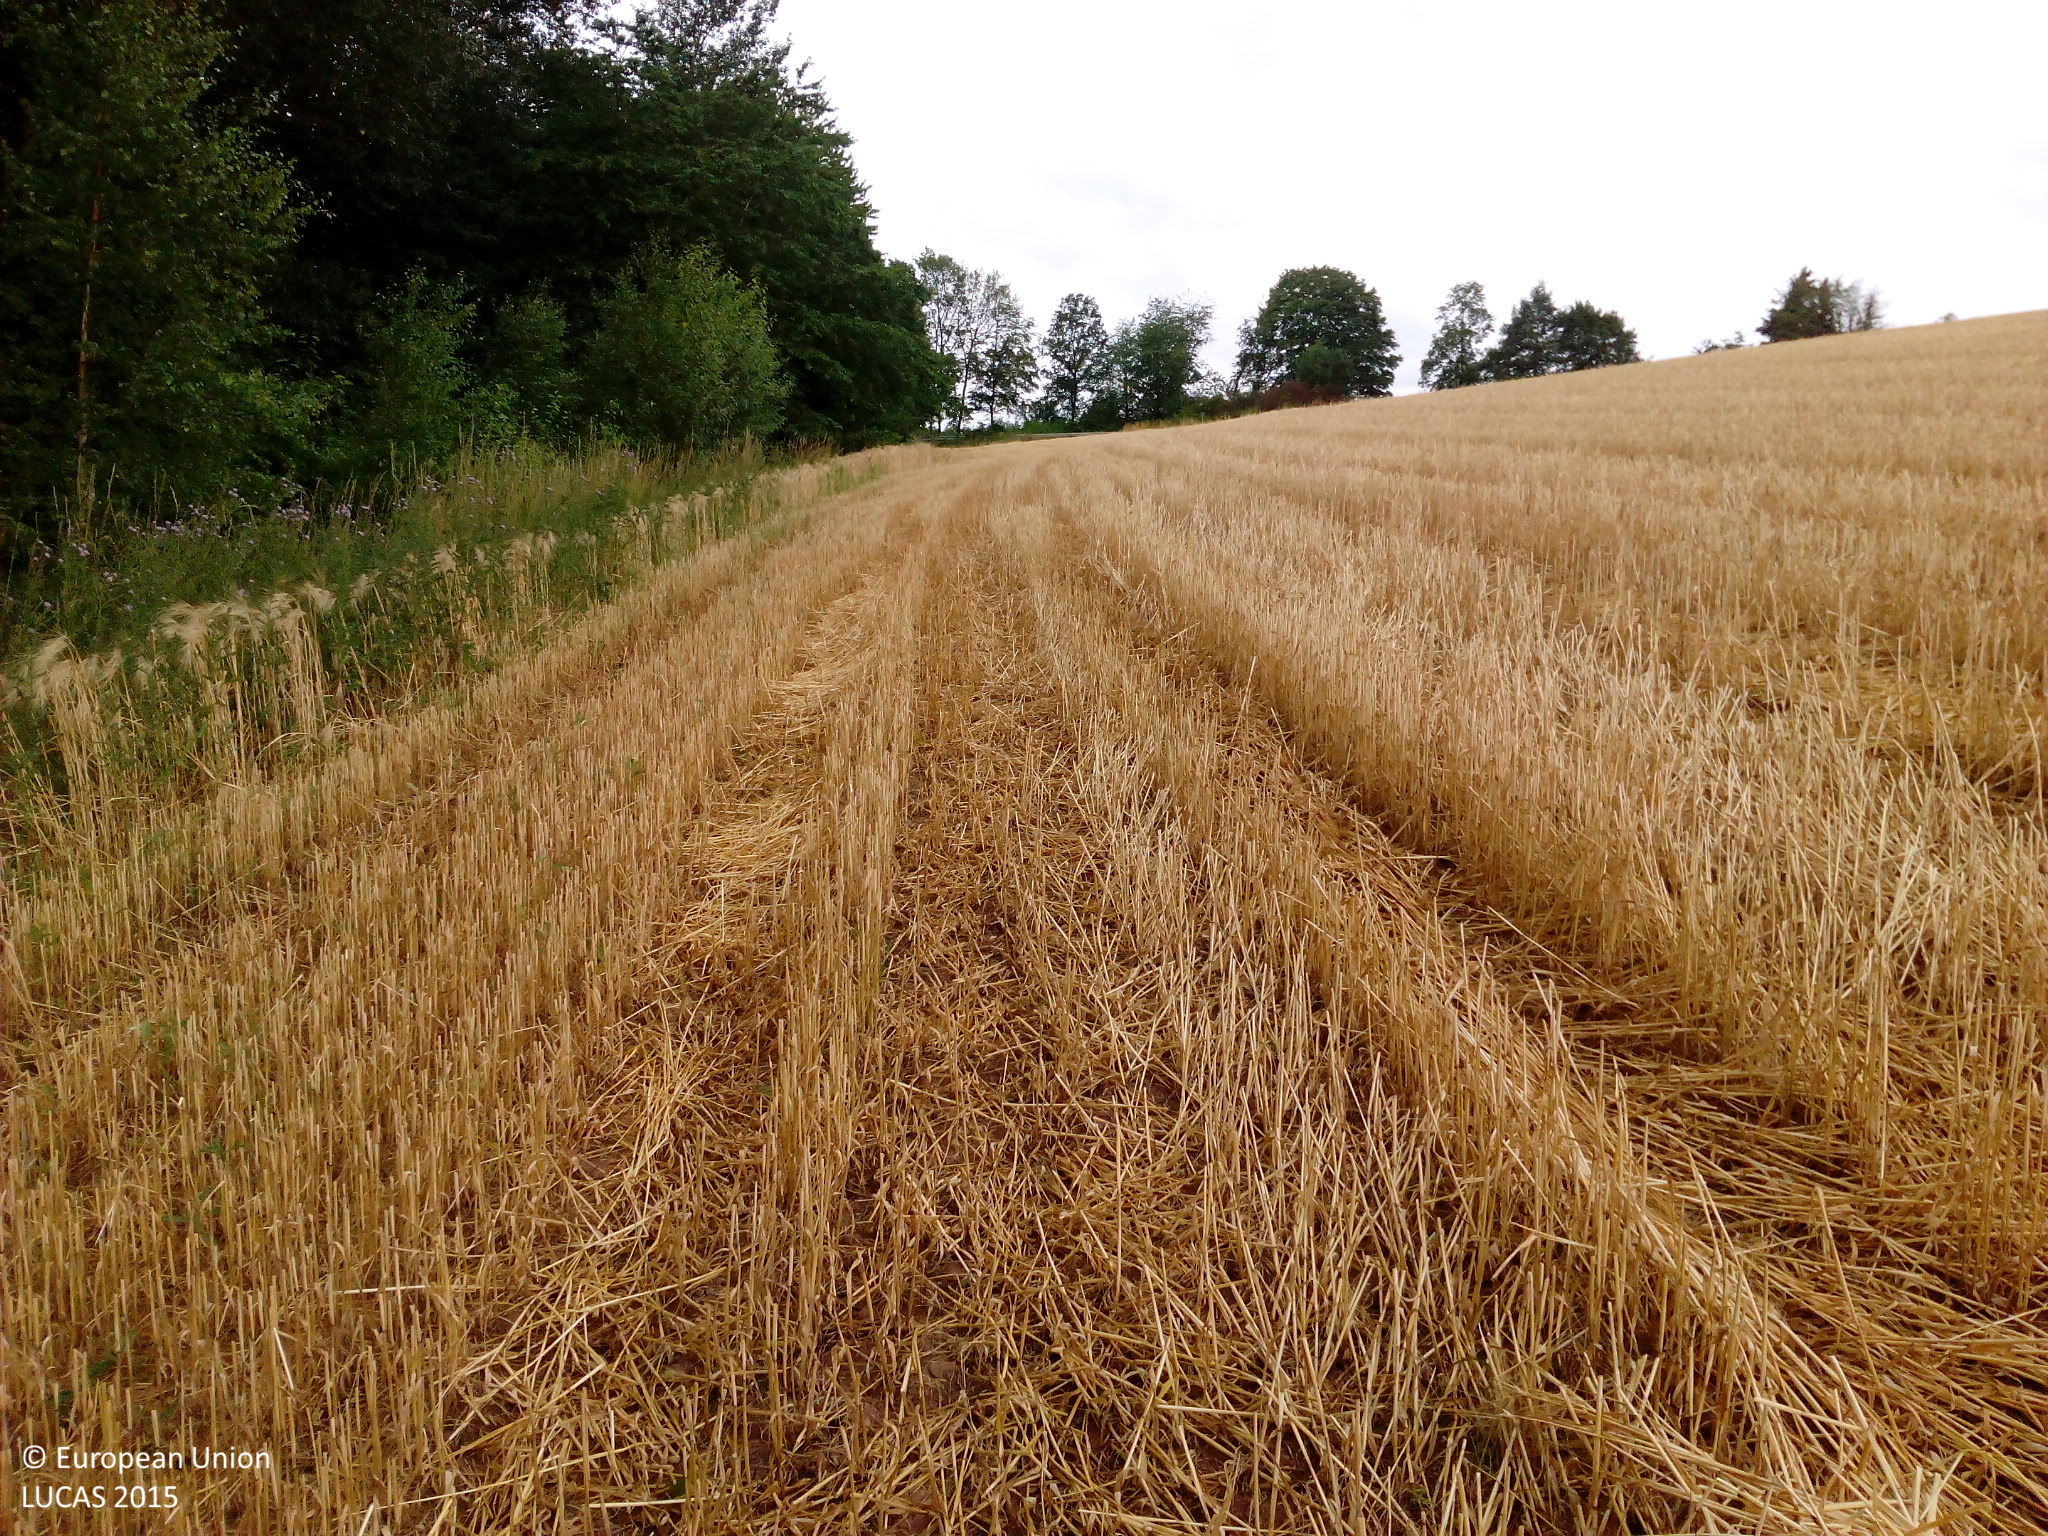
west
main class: Cropland
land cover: Barley
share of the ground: > 75 %
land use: Agriculture (excluding fallow land and kitchen gardens)
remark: Harvested field
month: July
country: DE
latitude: 49.3748
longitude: 7.1494
